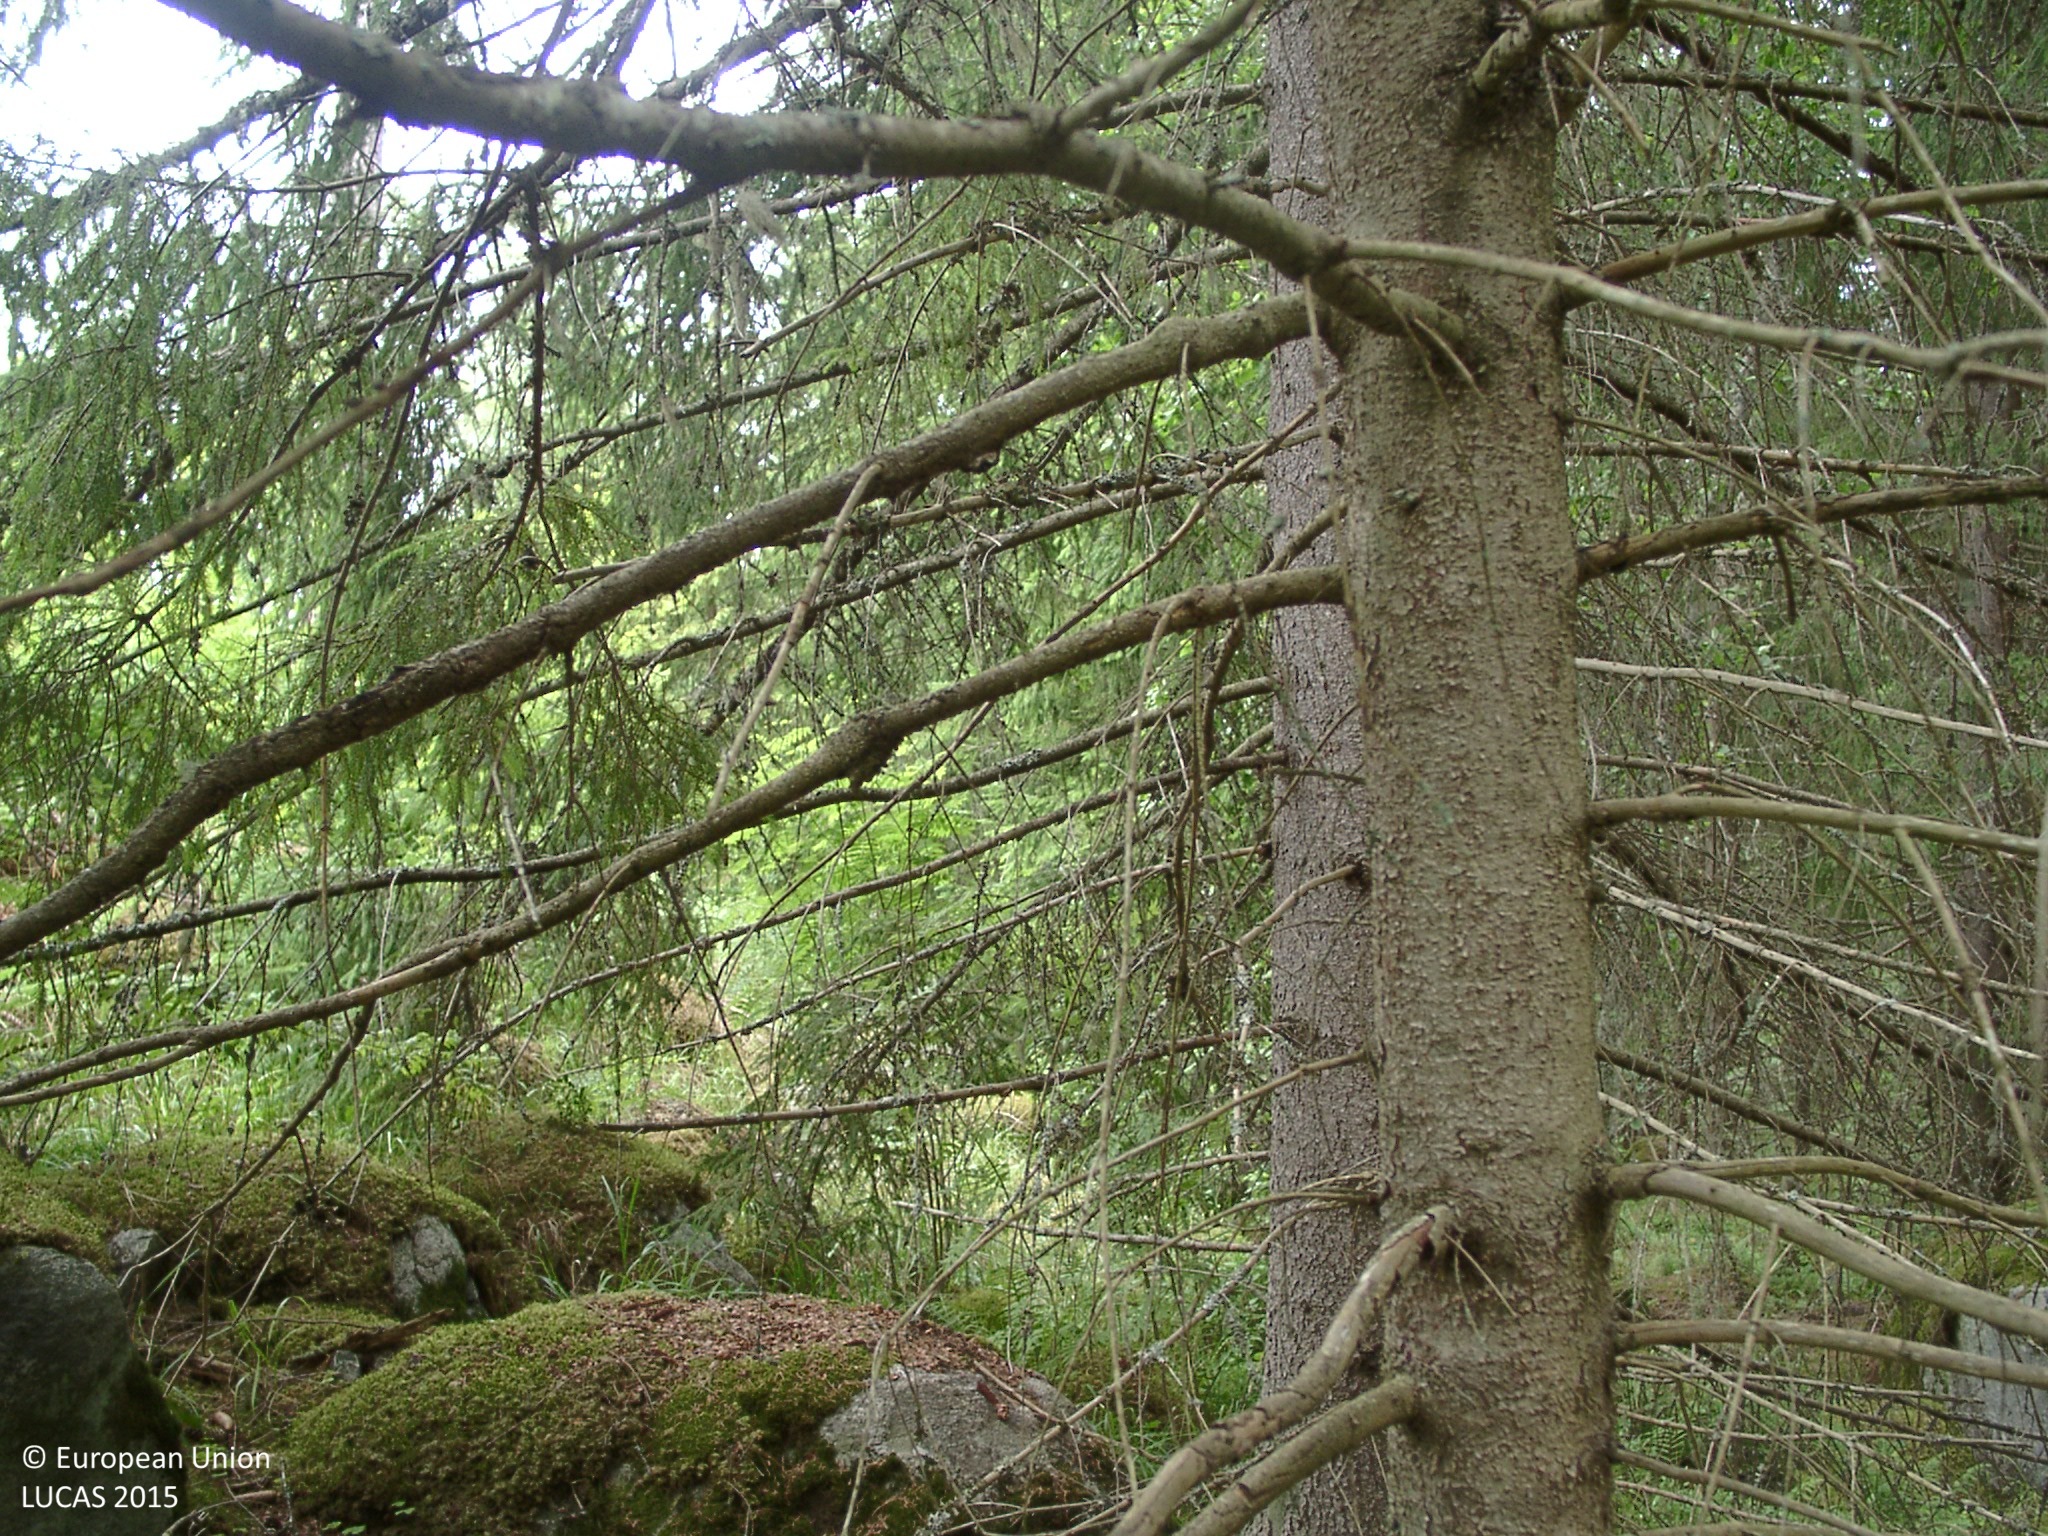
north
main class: Woodland
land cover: Spruce dominated coniferous woodland
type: boreal forest
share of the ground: > 75 %
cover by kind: coniferous forest trees 75 %, lichens and mosses 10 %, broadleaved forest trees 5 %, shrubs 5 %, herbaceous plants 5 %
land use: Forestry
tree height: > 5 m
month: July
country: FI
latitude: 61.5022
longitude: 25.2008
